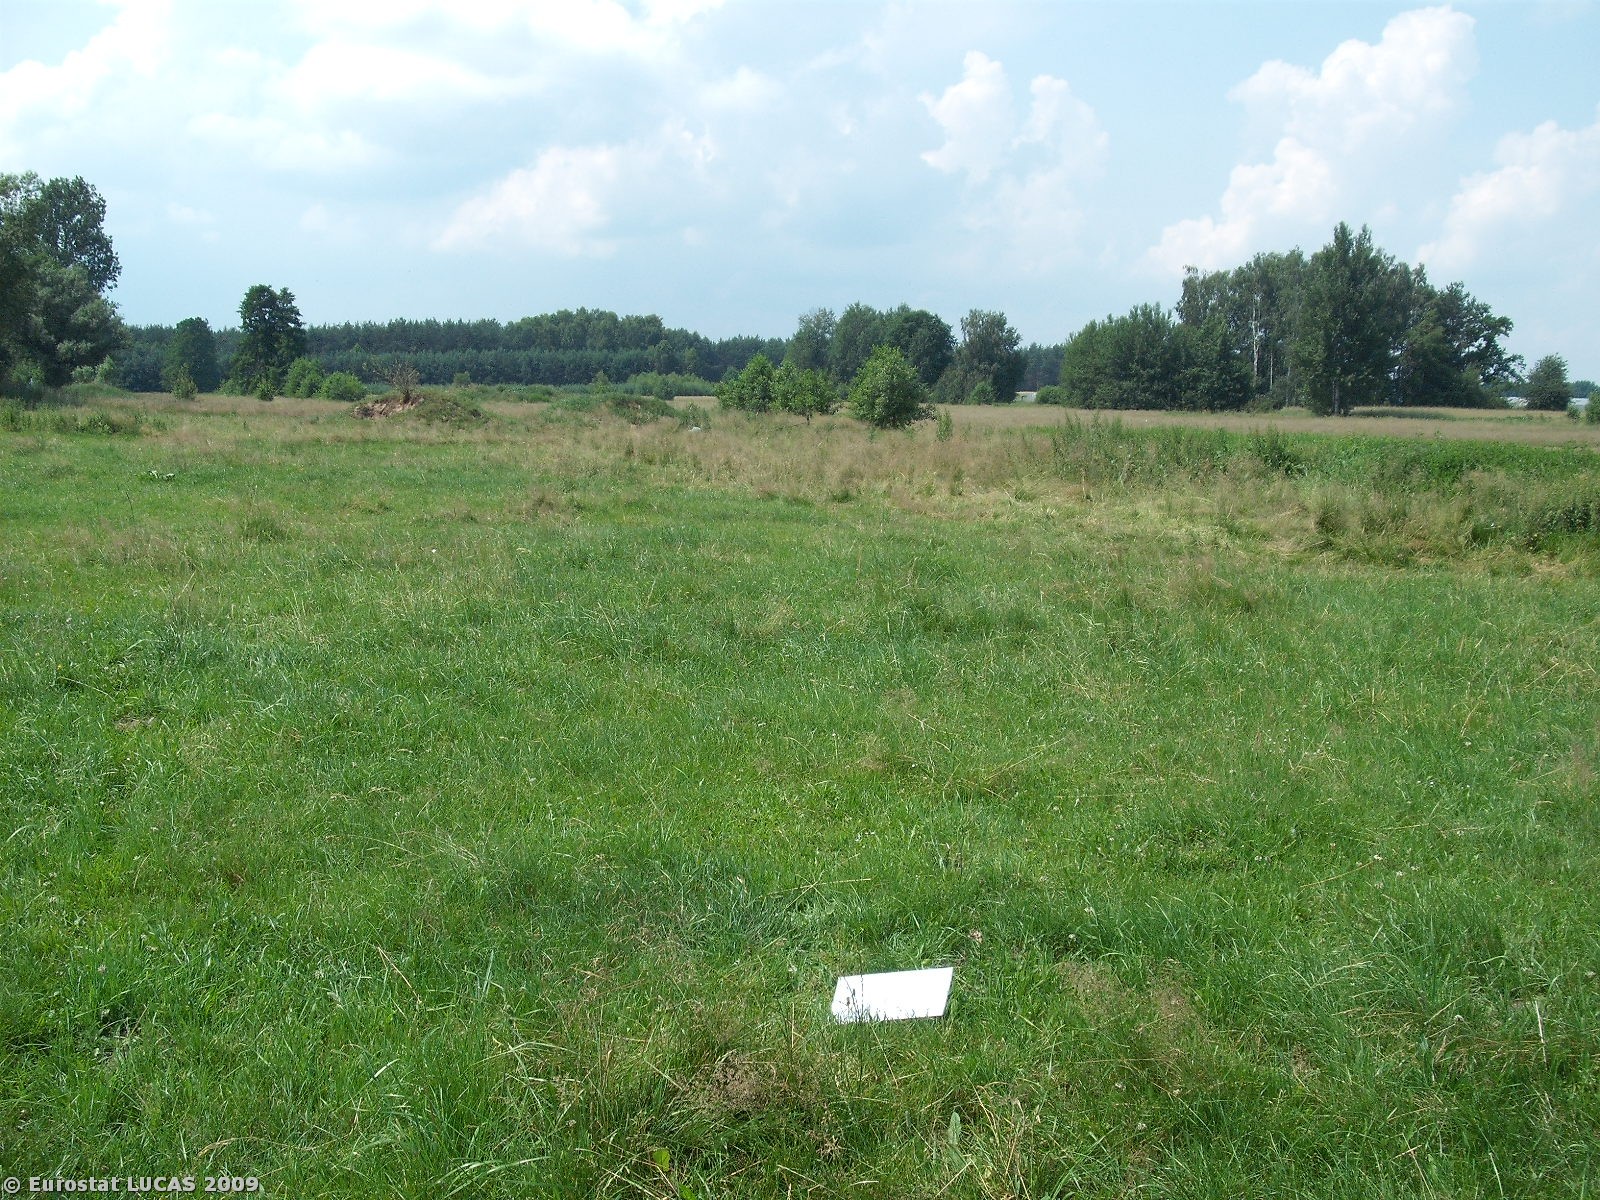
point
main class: Grassland
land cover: Grassland without tree/shrub cover
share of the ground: > 75 %
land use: Agriculture (excluding fallow land and kitchen gardens)
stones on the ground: < 10 %
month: July
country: PL
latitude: 51.4847
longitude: 20.5952
